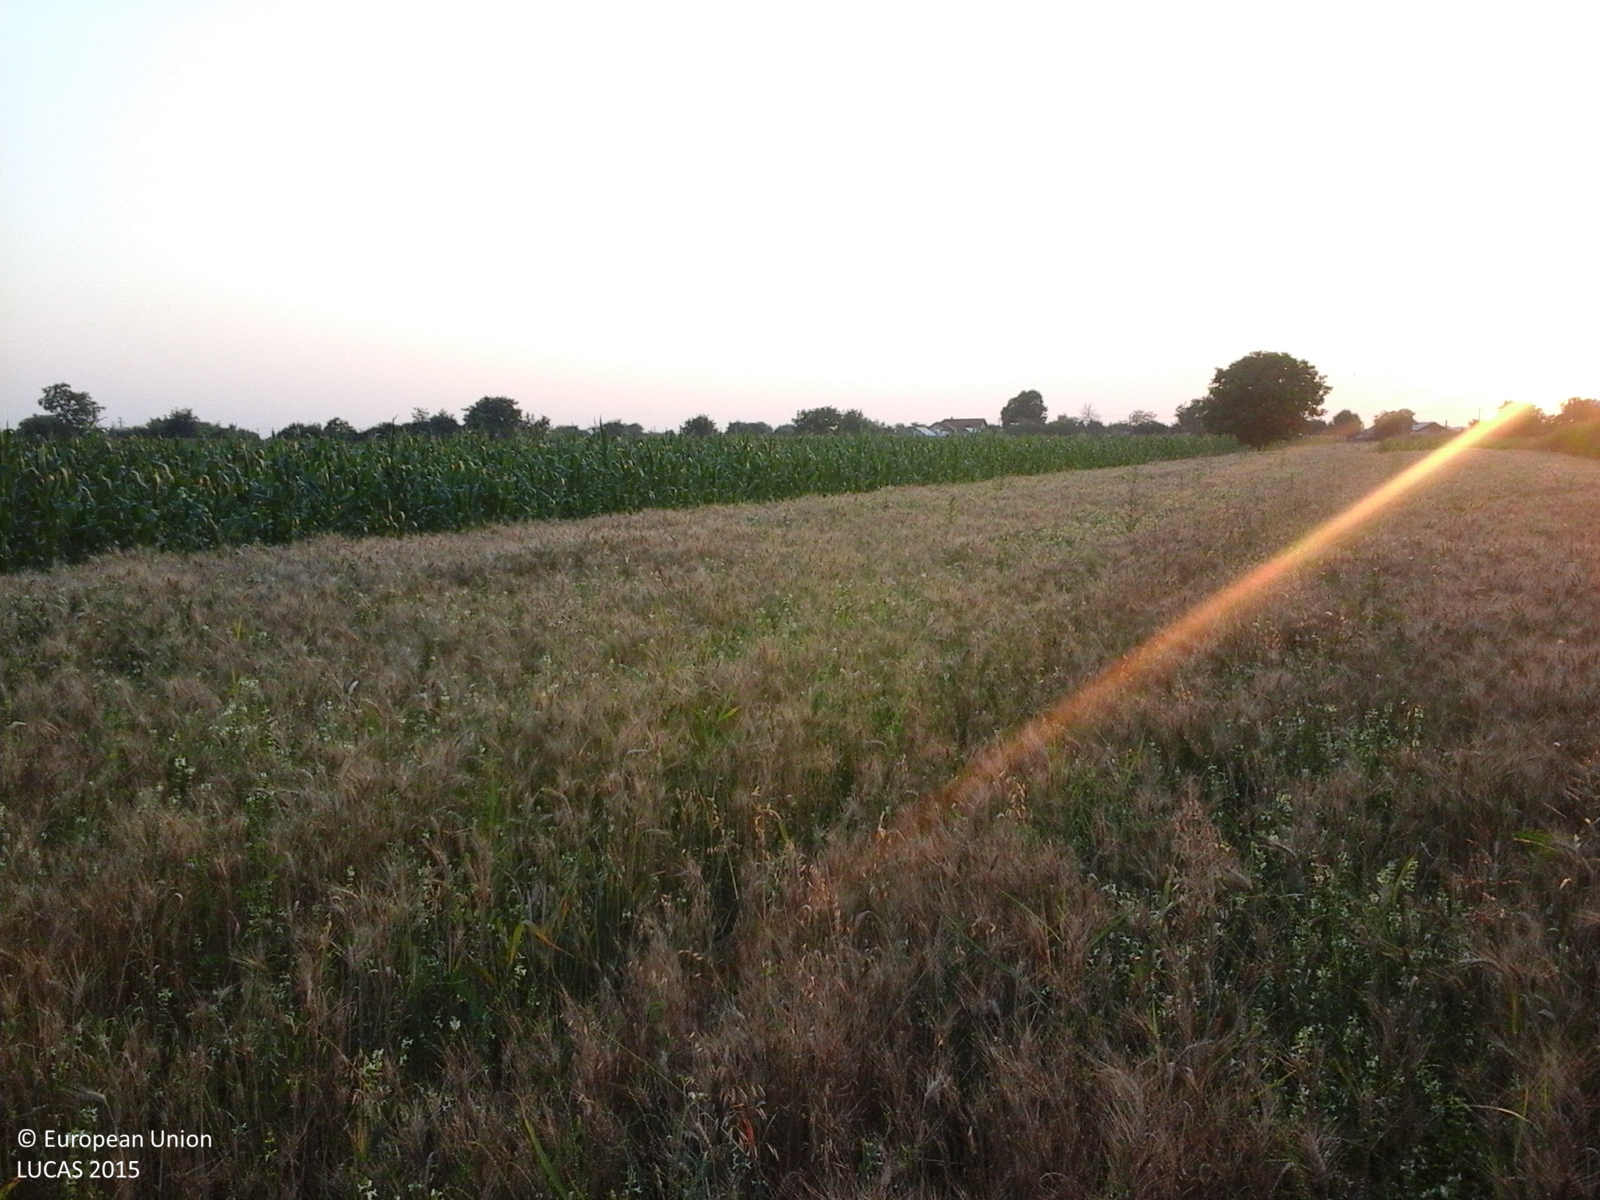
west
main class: Cropland
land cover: Barley
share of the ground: > 75 %
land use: Agriculture (excluding fallow land and kitchen gardens)
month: July
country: RO
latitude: 44.8134
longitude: 25.7162
